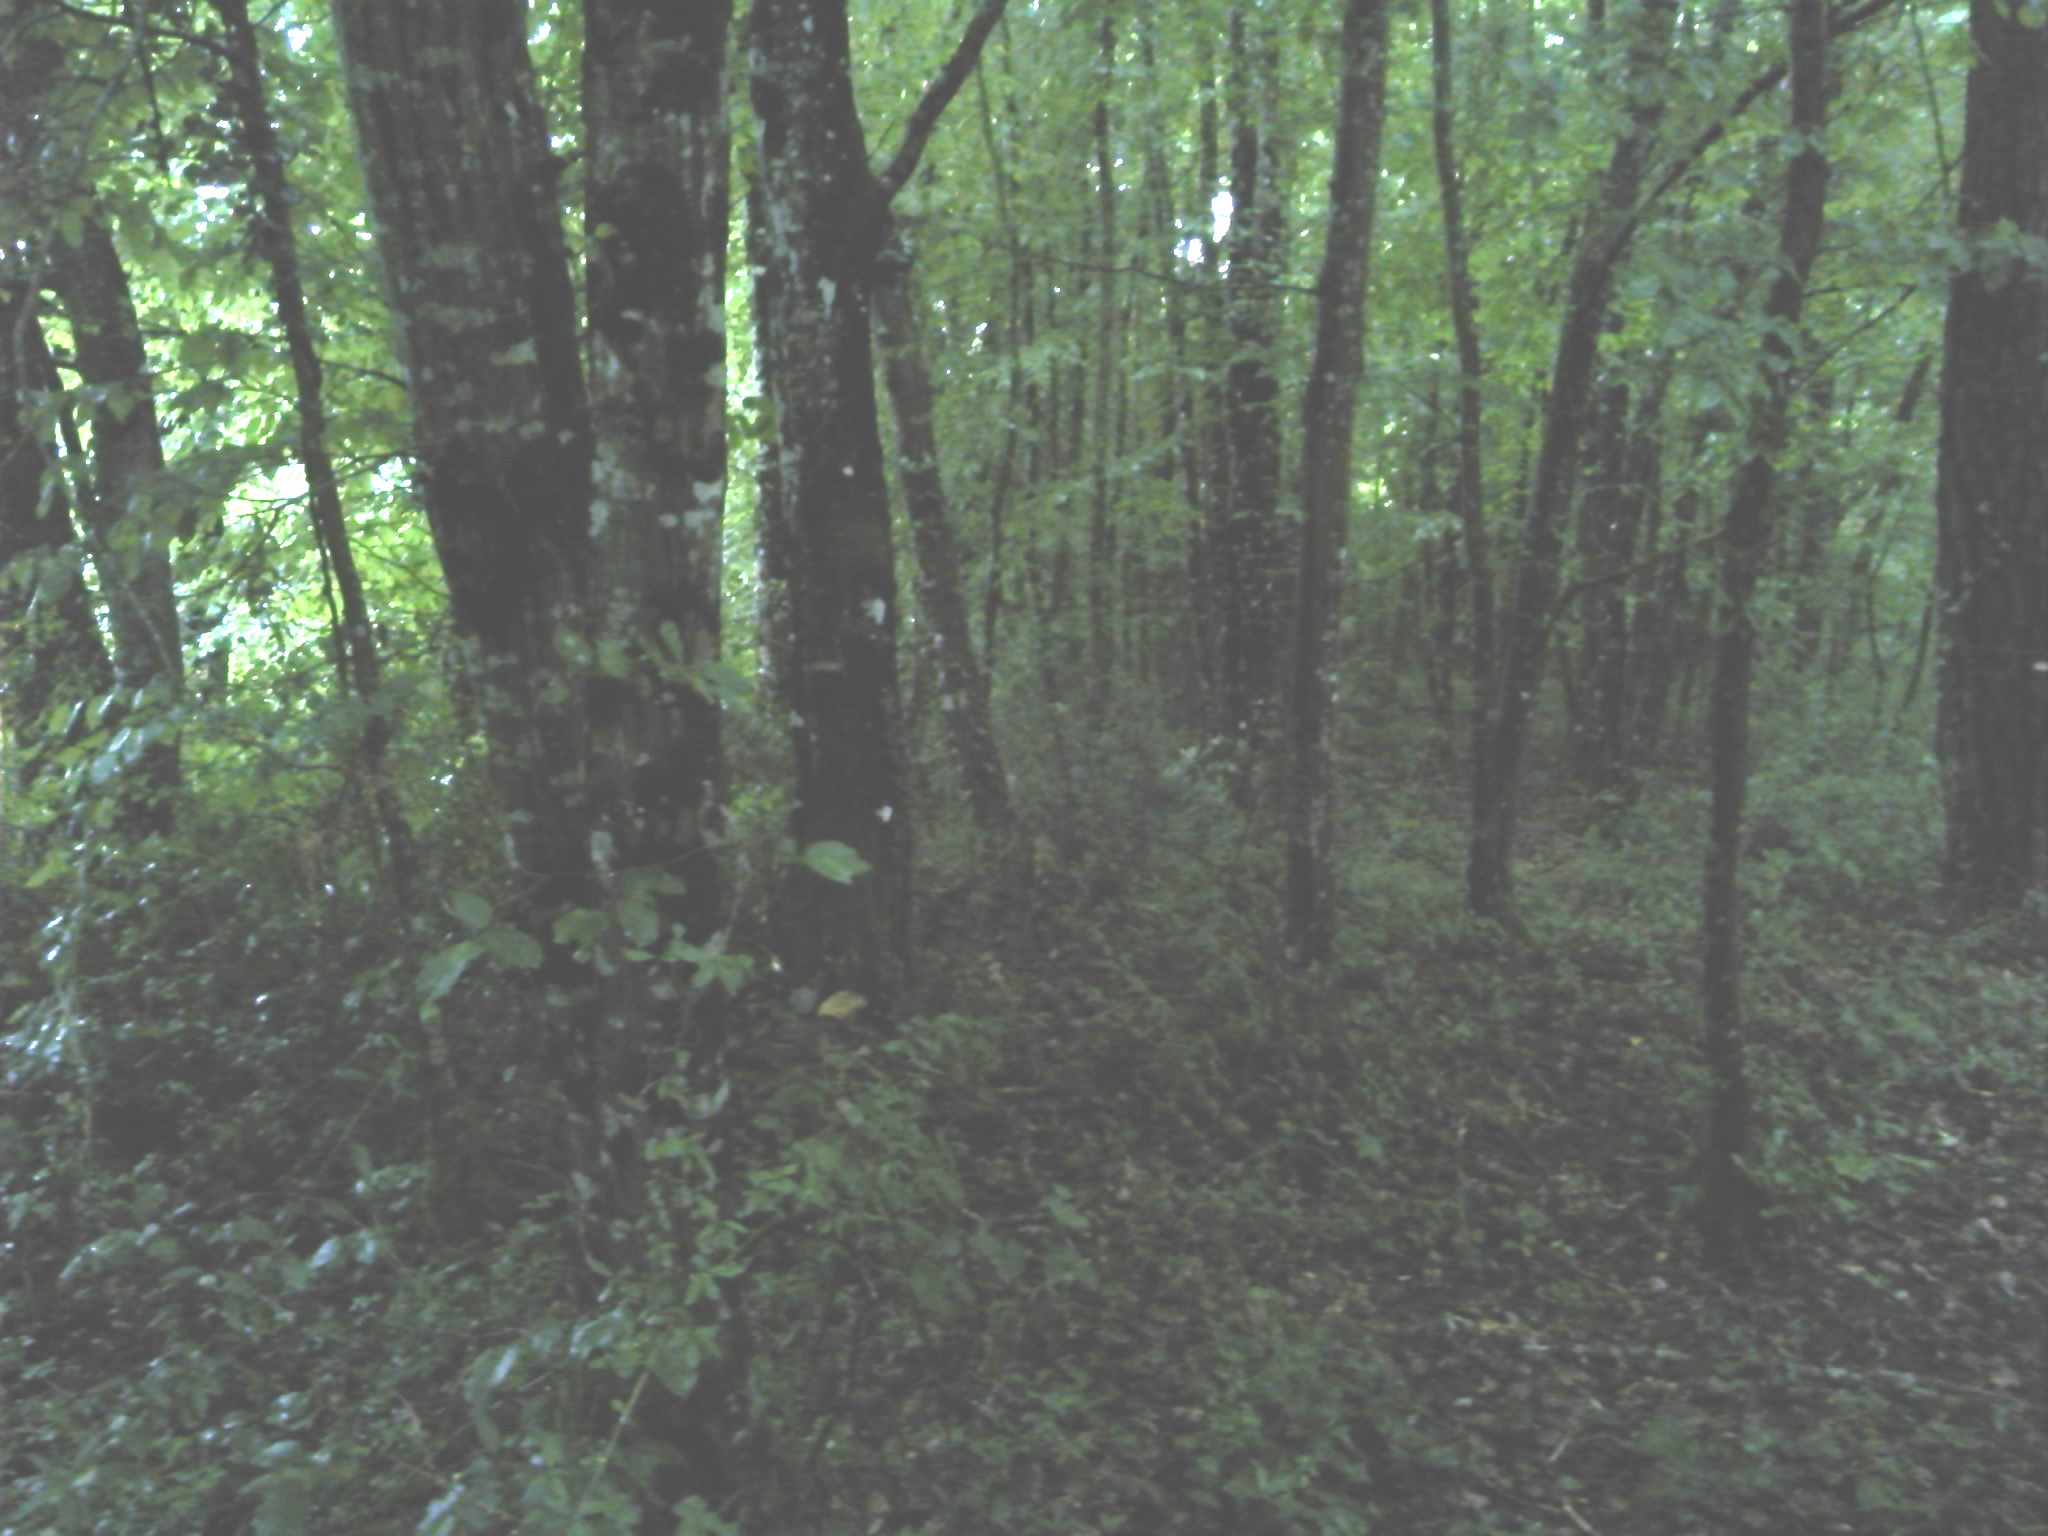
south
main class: Woodland
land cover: Broadleaved woodland
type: mesophytic deciduous forest
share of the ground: > 75 %
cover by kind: broadleaved forest trees 70 %, shrubs 20 %, herbaceous plants 5 %, lichens and mosses 5 %
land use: Forestry
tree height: > 5 m
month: June
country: FR
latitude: 46.5303
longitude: 1.1872
